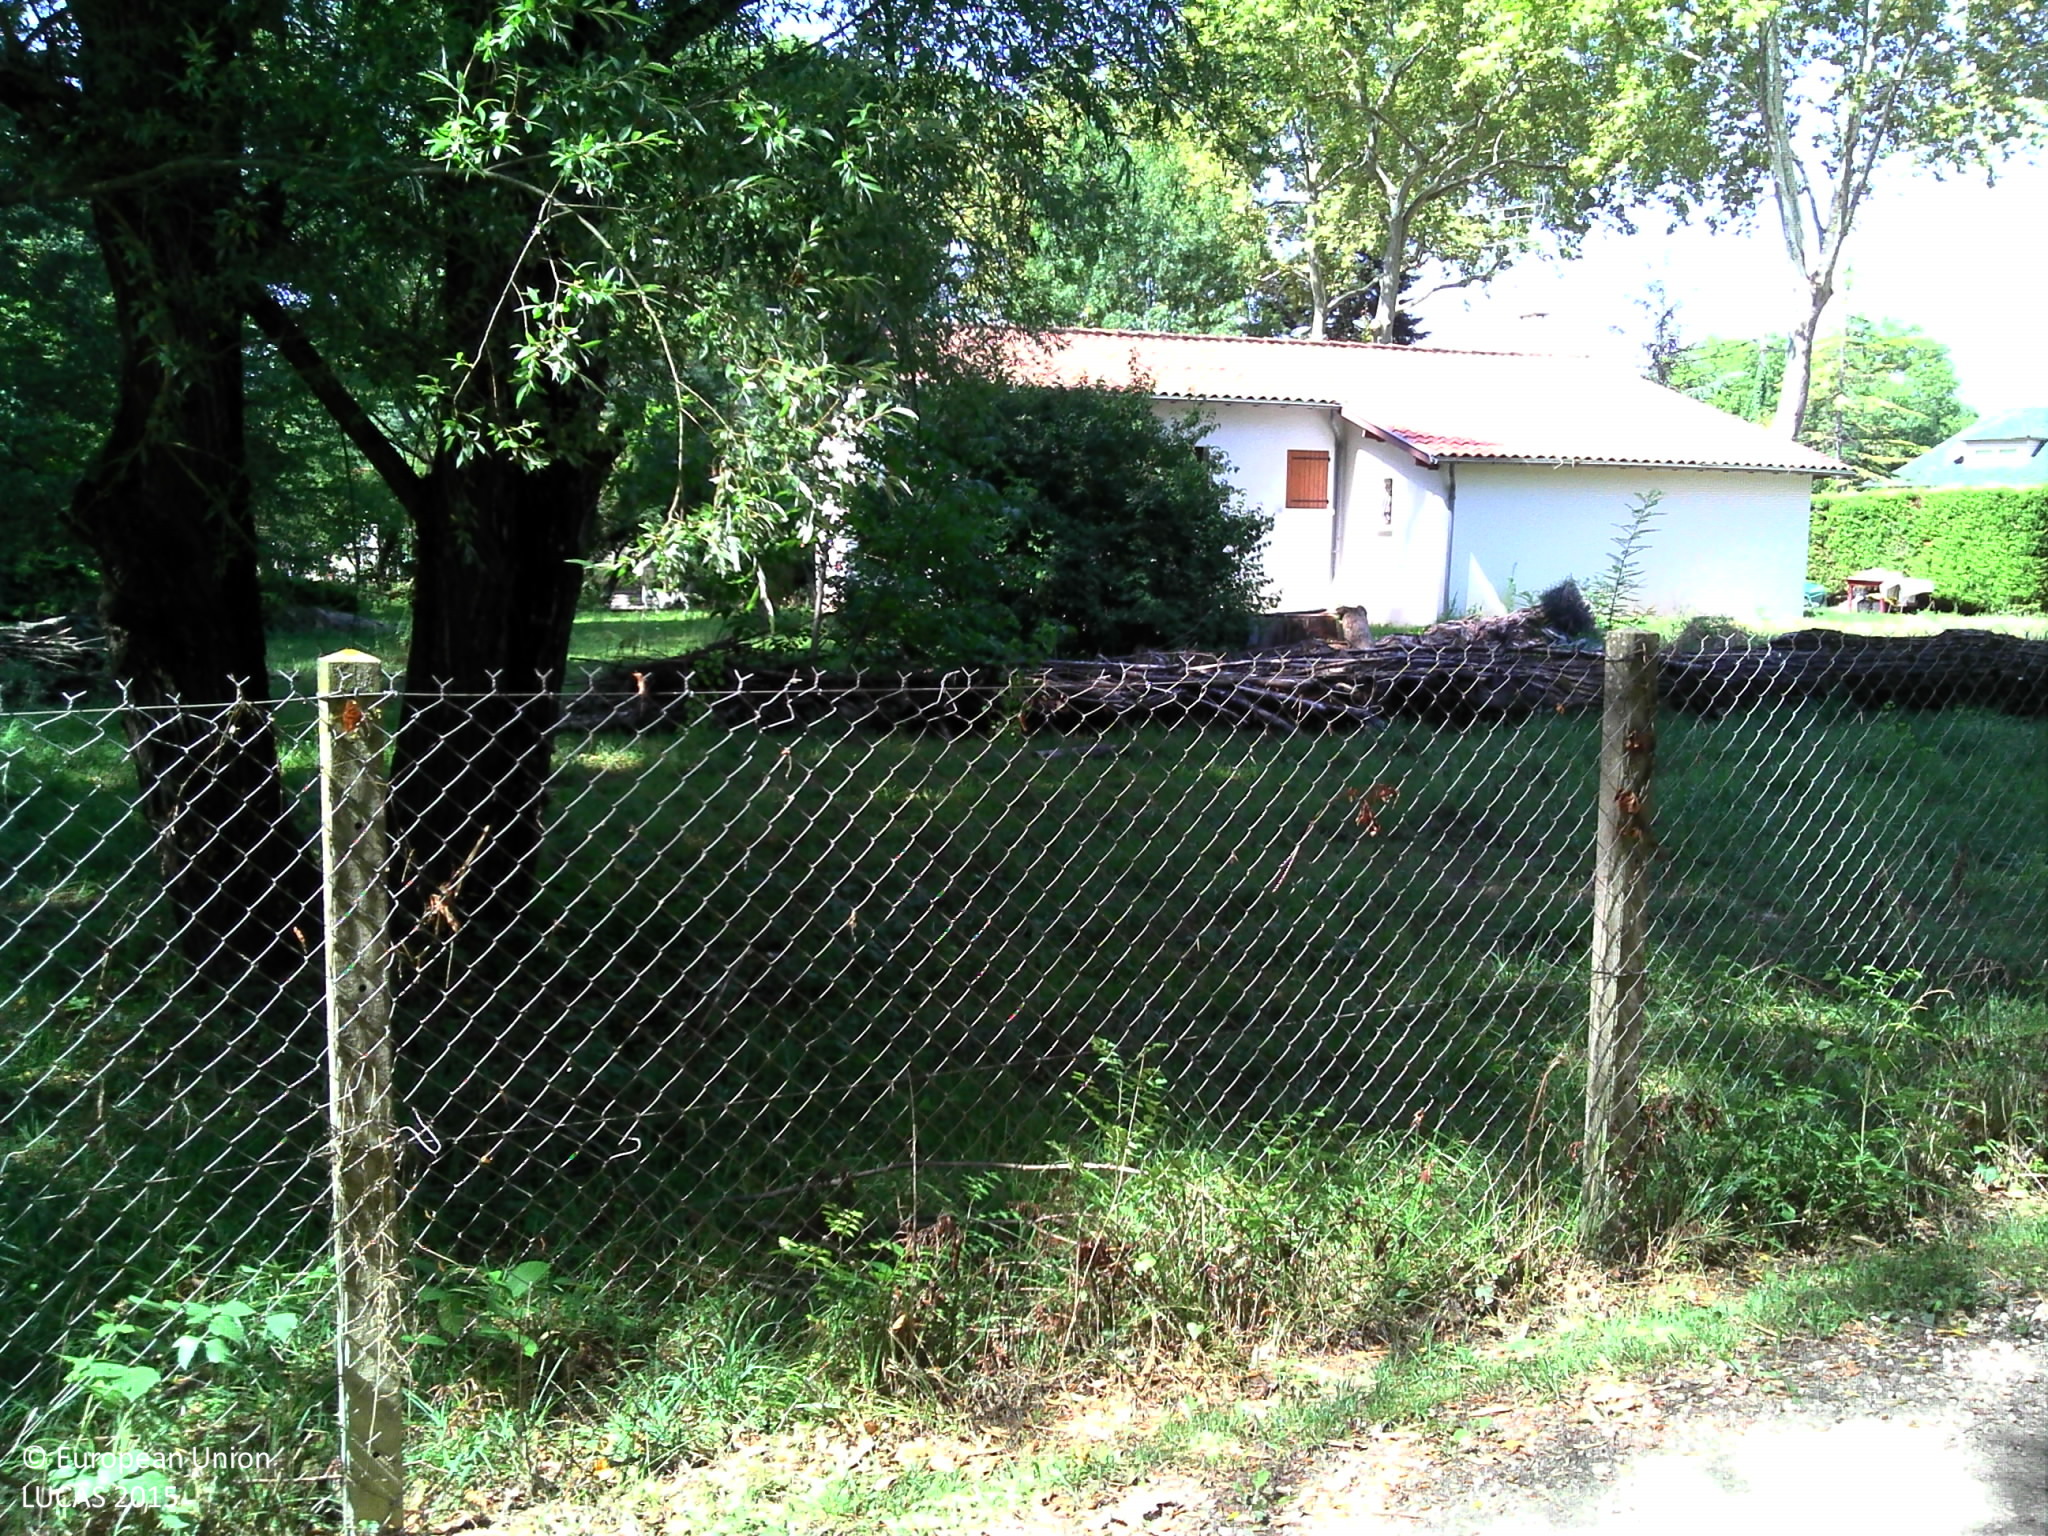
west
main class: Grassland
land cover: Grassland with sparse tree/shrub cover
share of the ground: > 75 %
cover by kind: herbaceous plants 90 %, broadleaved forest trees 5 %, shrubs 5 %
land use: Residential
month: August
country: FR
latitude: 44.1692
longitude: 1.5583
